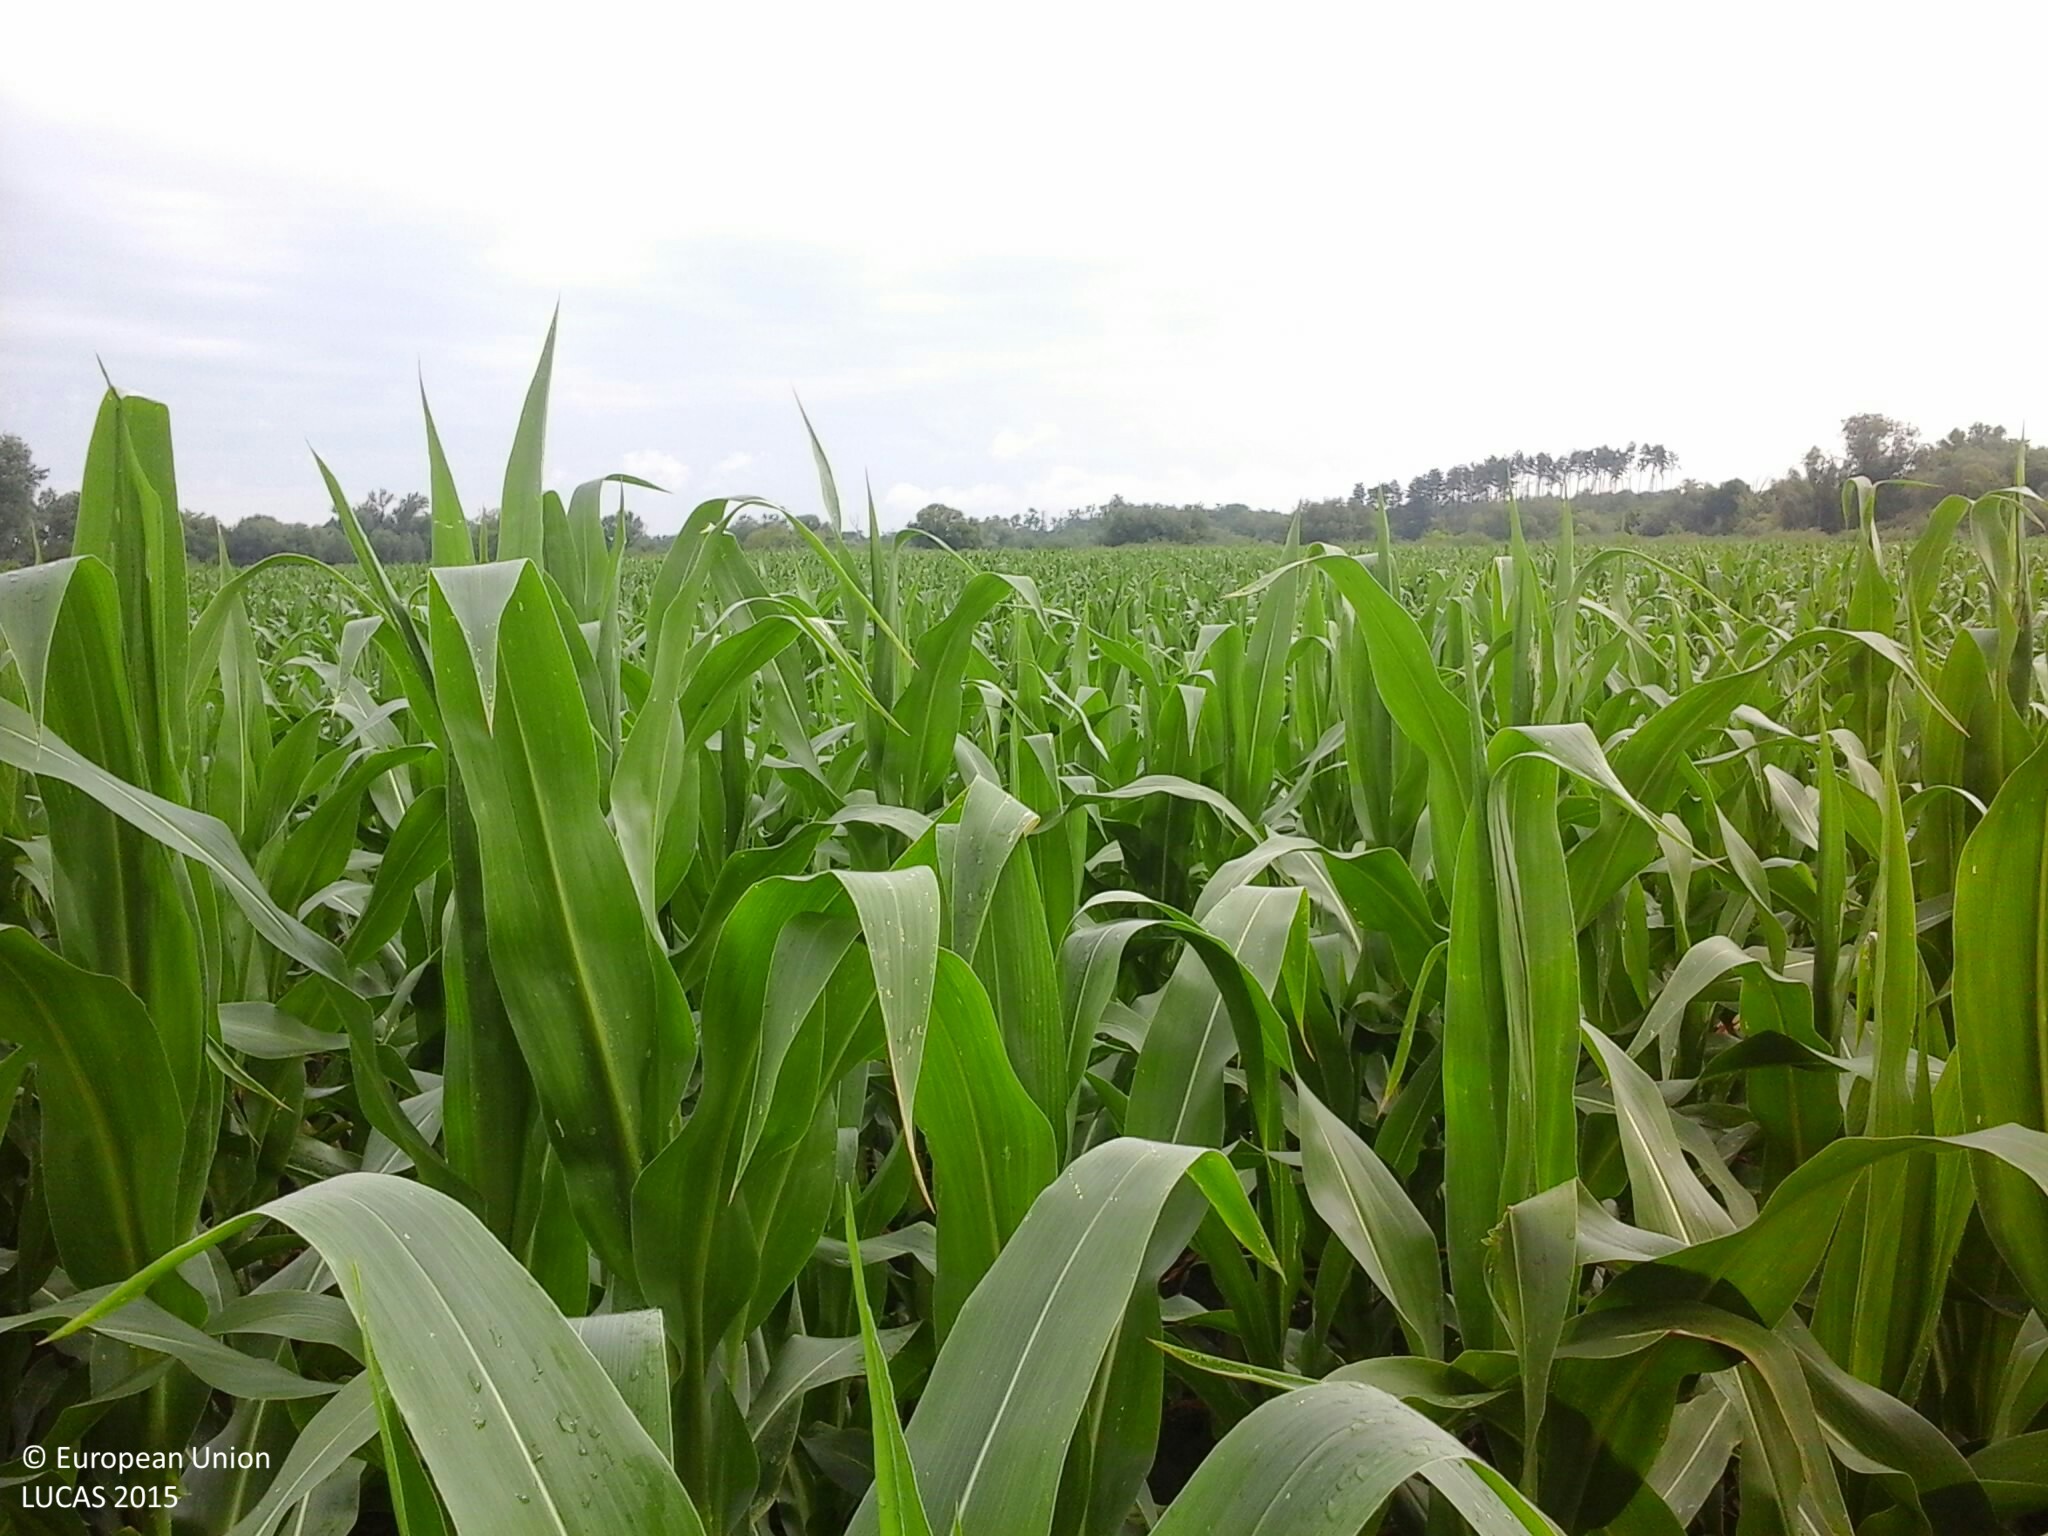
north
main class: Cropland
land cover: Maize
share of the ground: > 75 %
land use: Agriculture (excluding fallow land and kitchen gardens)
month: July
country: HU
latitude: 47.7898
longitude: 21.9439
